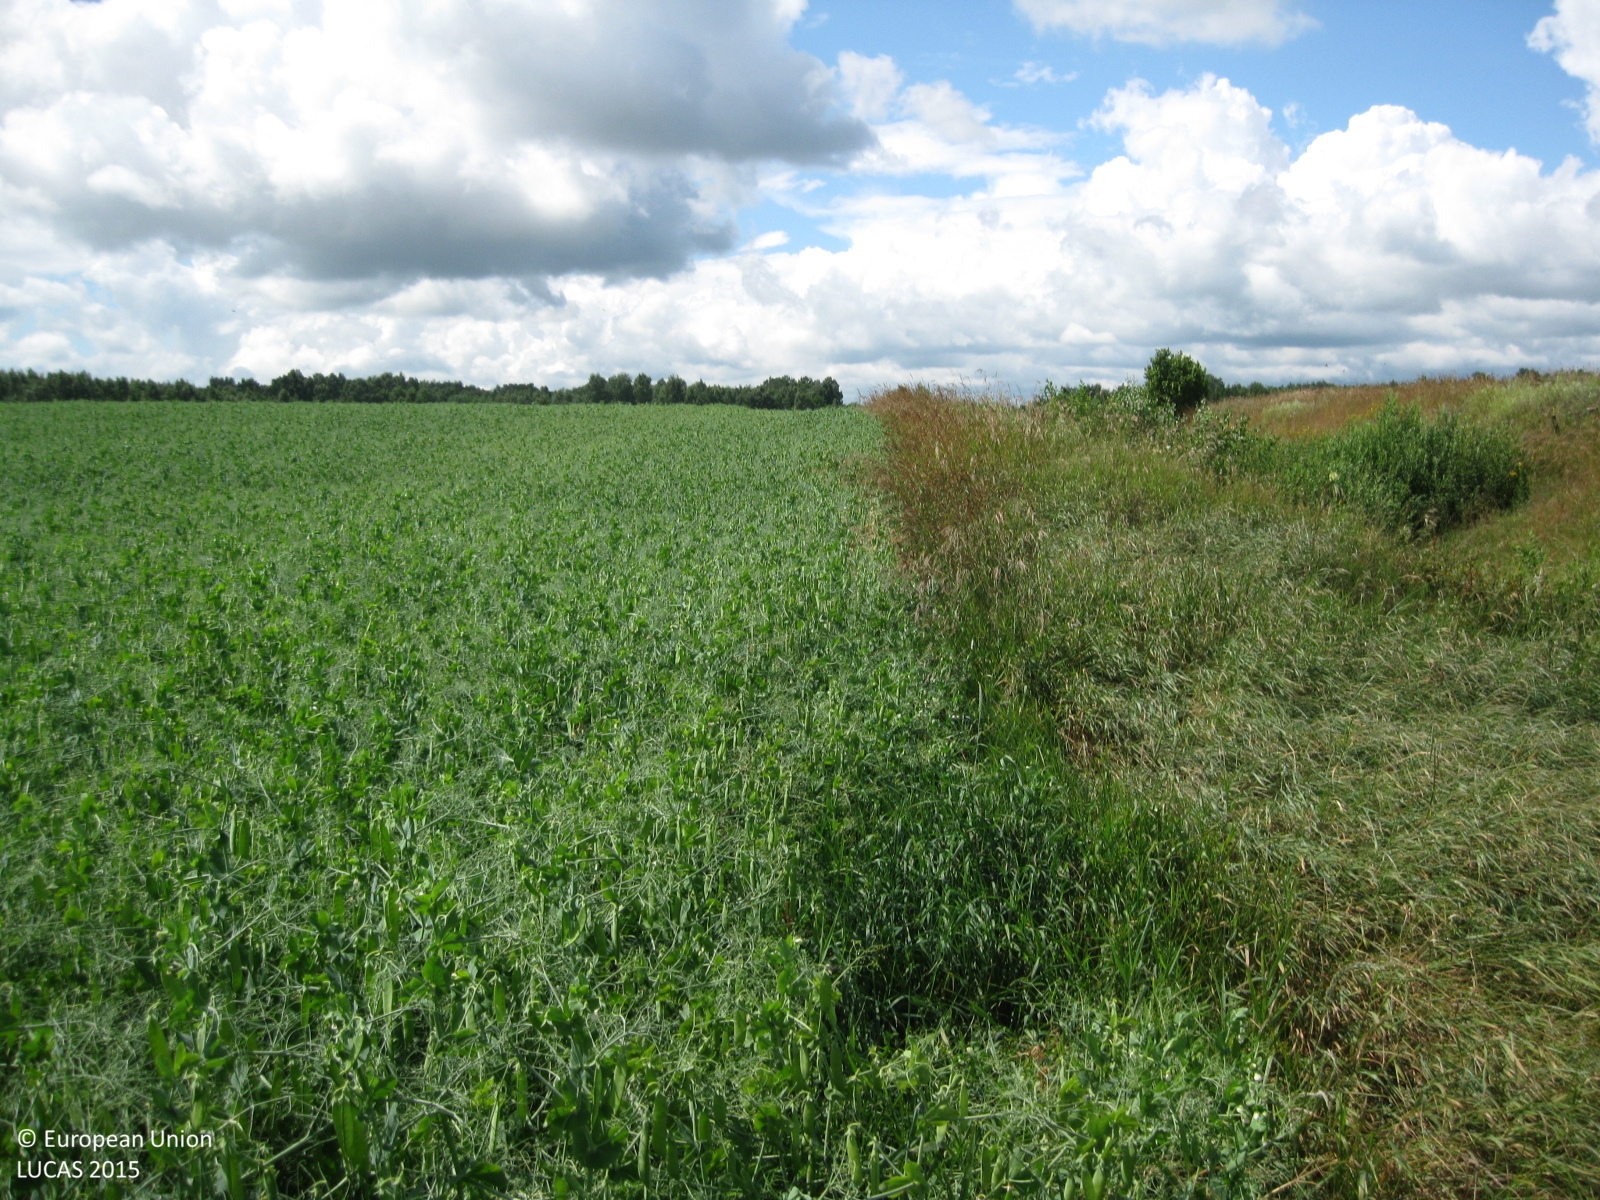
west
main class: Cropland
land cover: Dry pulses
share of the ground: > 75 %
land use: Agriculture (excluding fallow land and kitchen gardens)
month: July
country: LT
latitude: 55.6919
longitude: 24.3010
